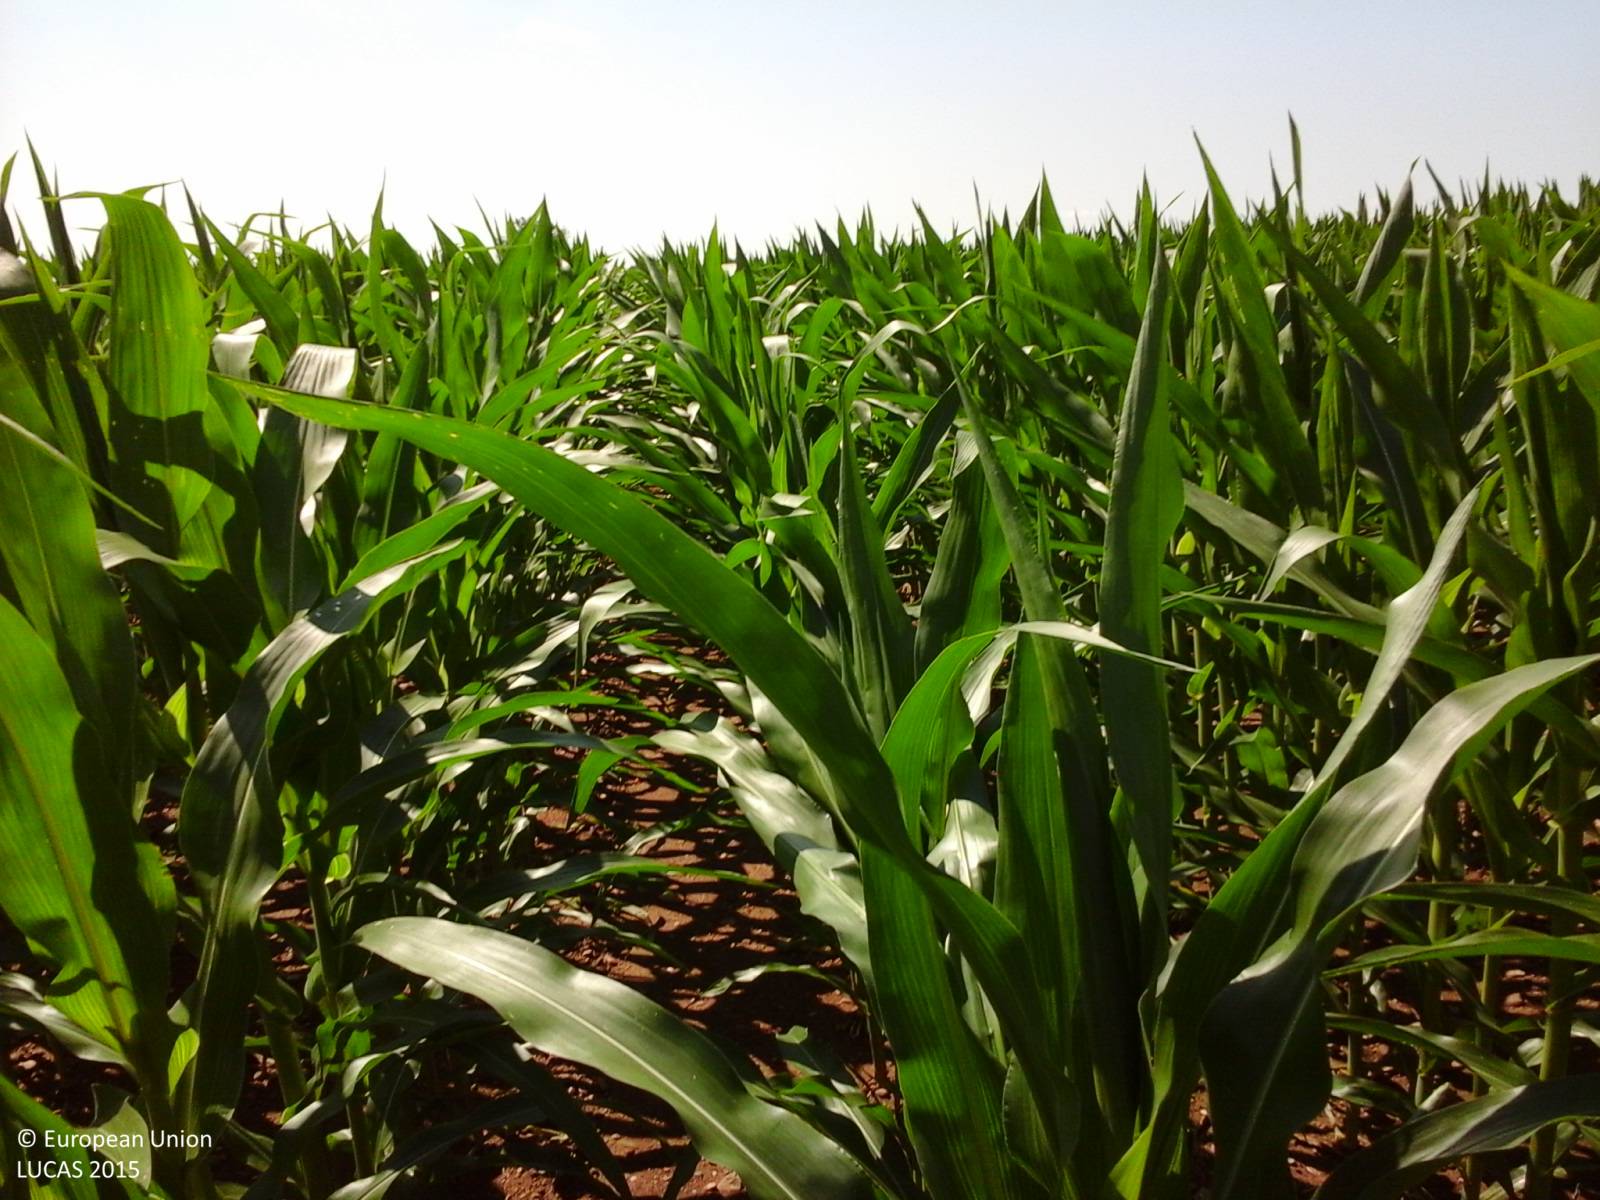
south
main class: Cropland
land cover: Maize
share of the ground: > 75 %
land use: Agriculture (excluding fallow land and kitchen gardens)
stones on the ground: < 10 %
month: June
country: IT
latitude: 46.1405
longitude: 13.2199
